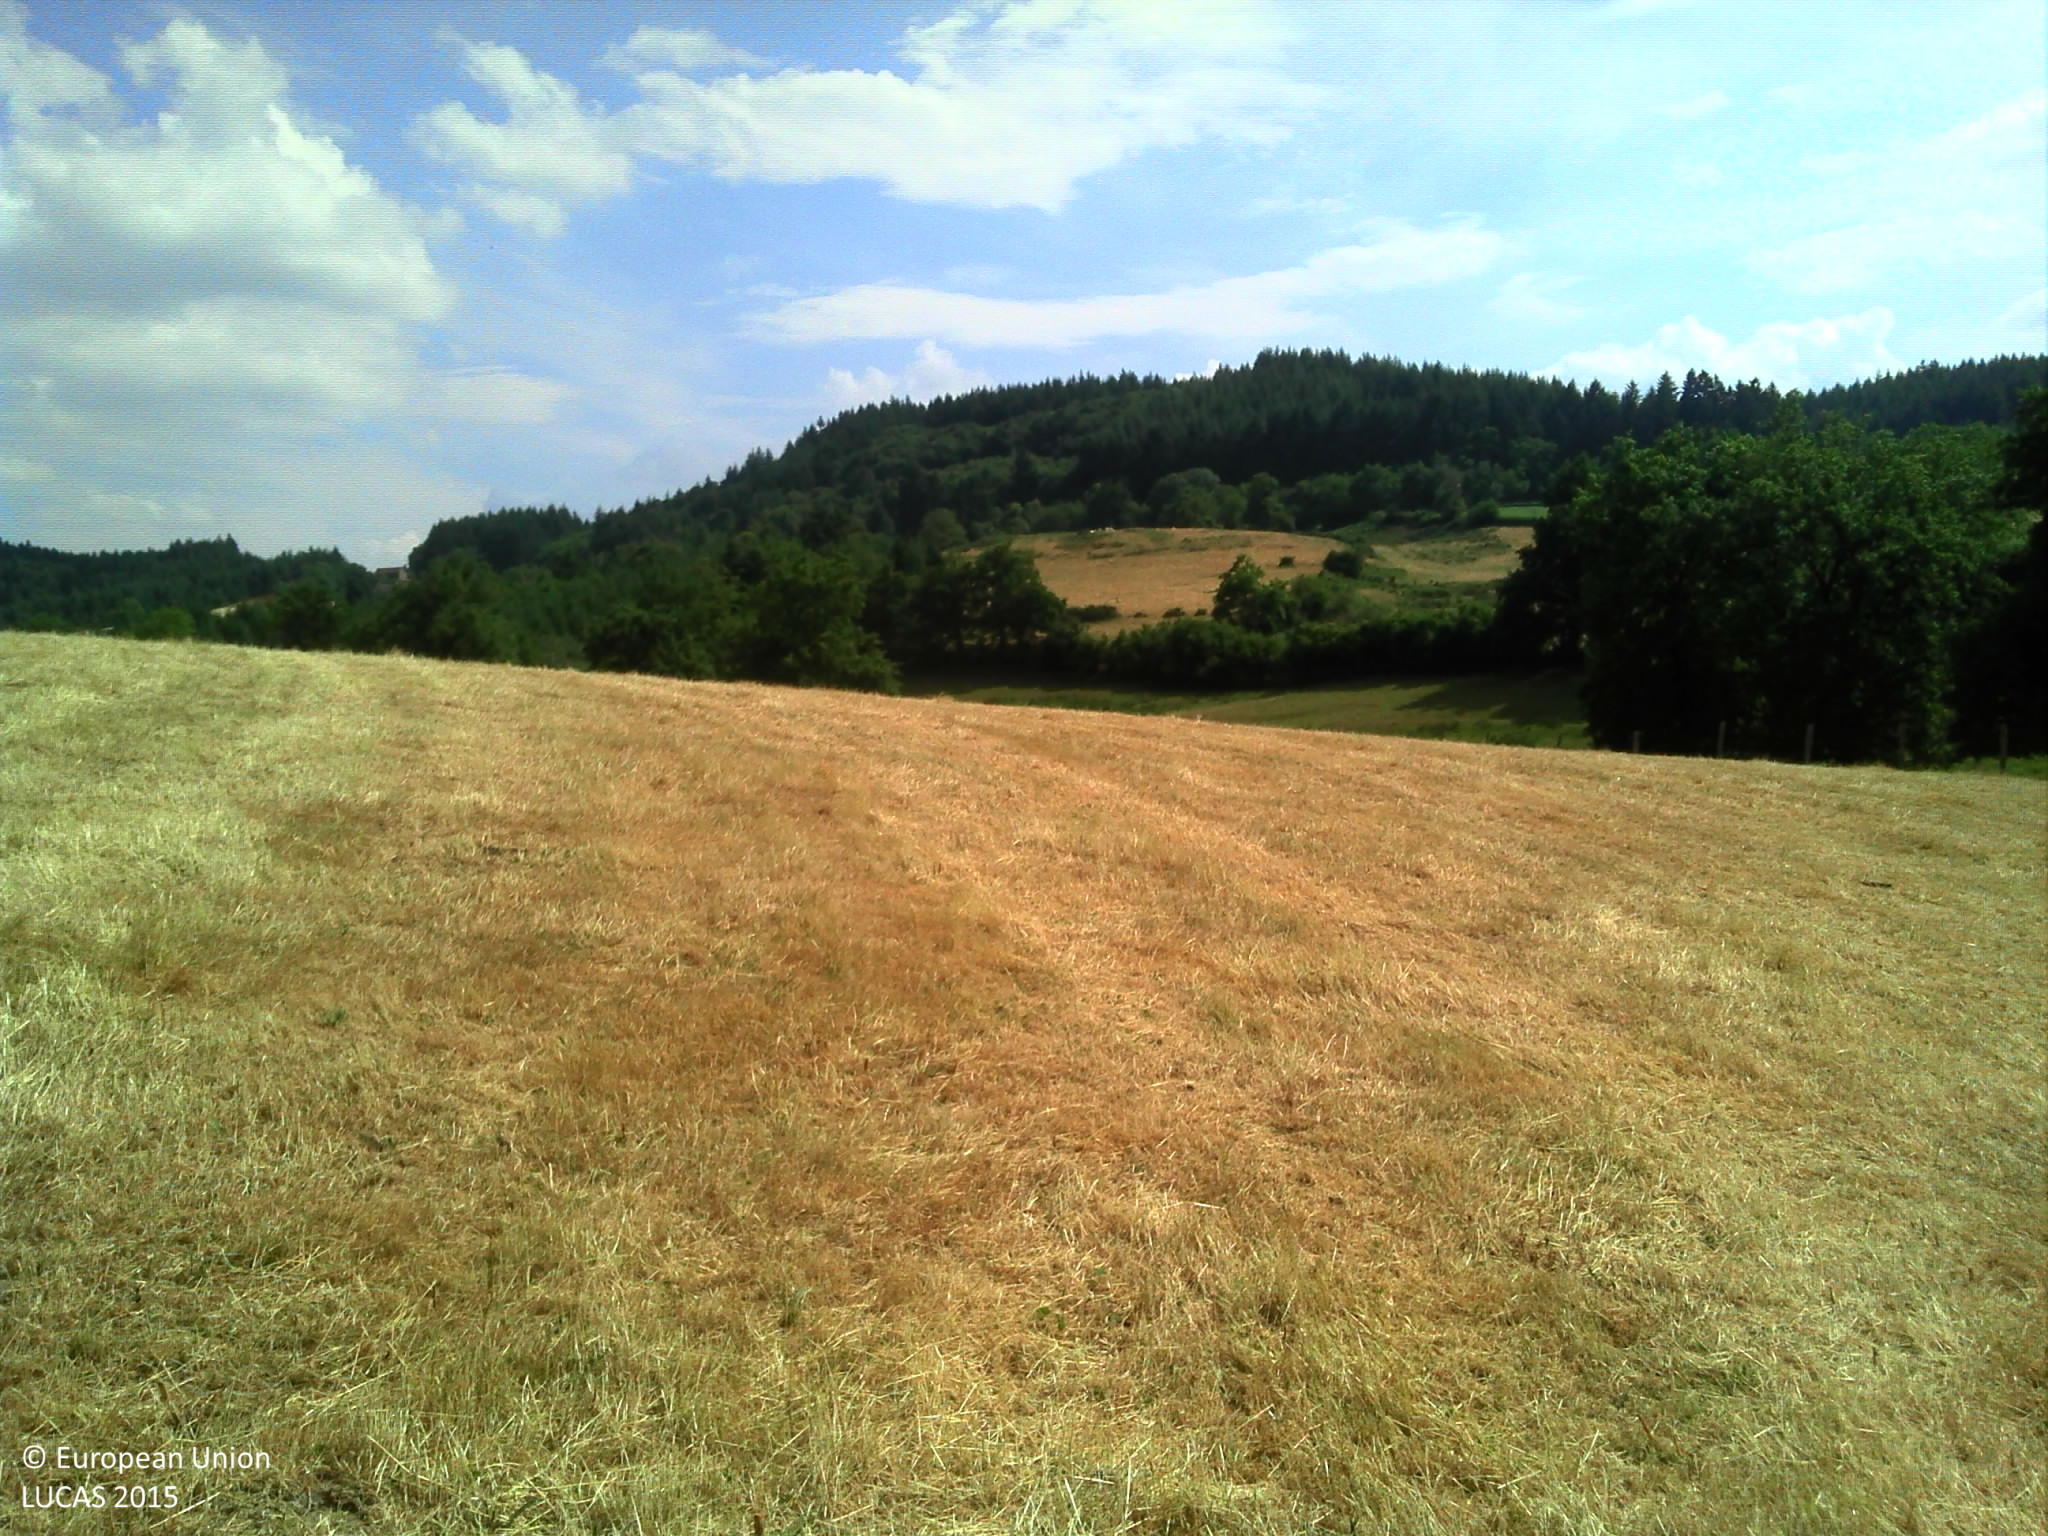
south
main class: Grassland
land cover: Grassland without tree/shrub cover
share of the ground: > 75 %
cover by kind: herbaceous plants 100 %
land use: Agriculture (excluding fallow land and kitchen gardens)
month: June
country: FR
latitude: 46.3670
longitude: 4.3990
